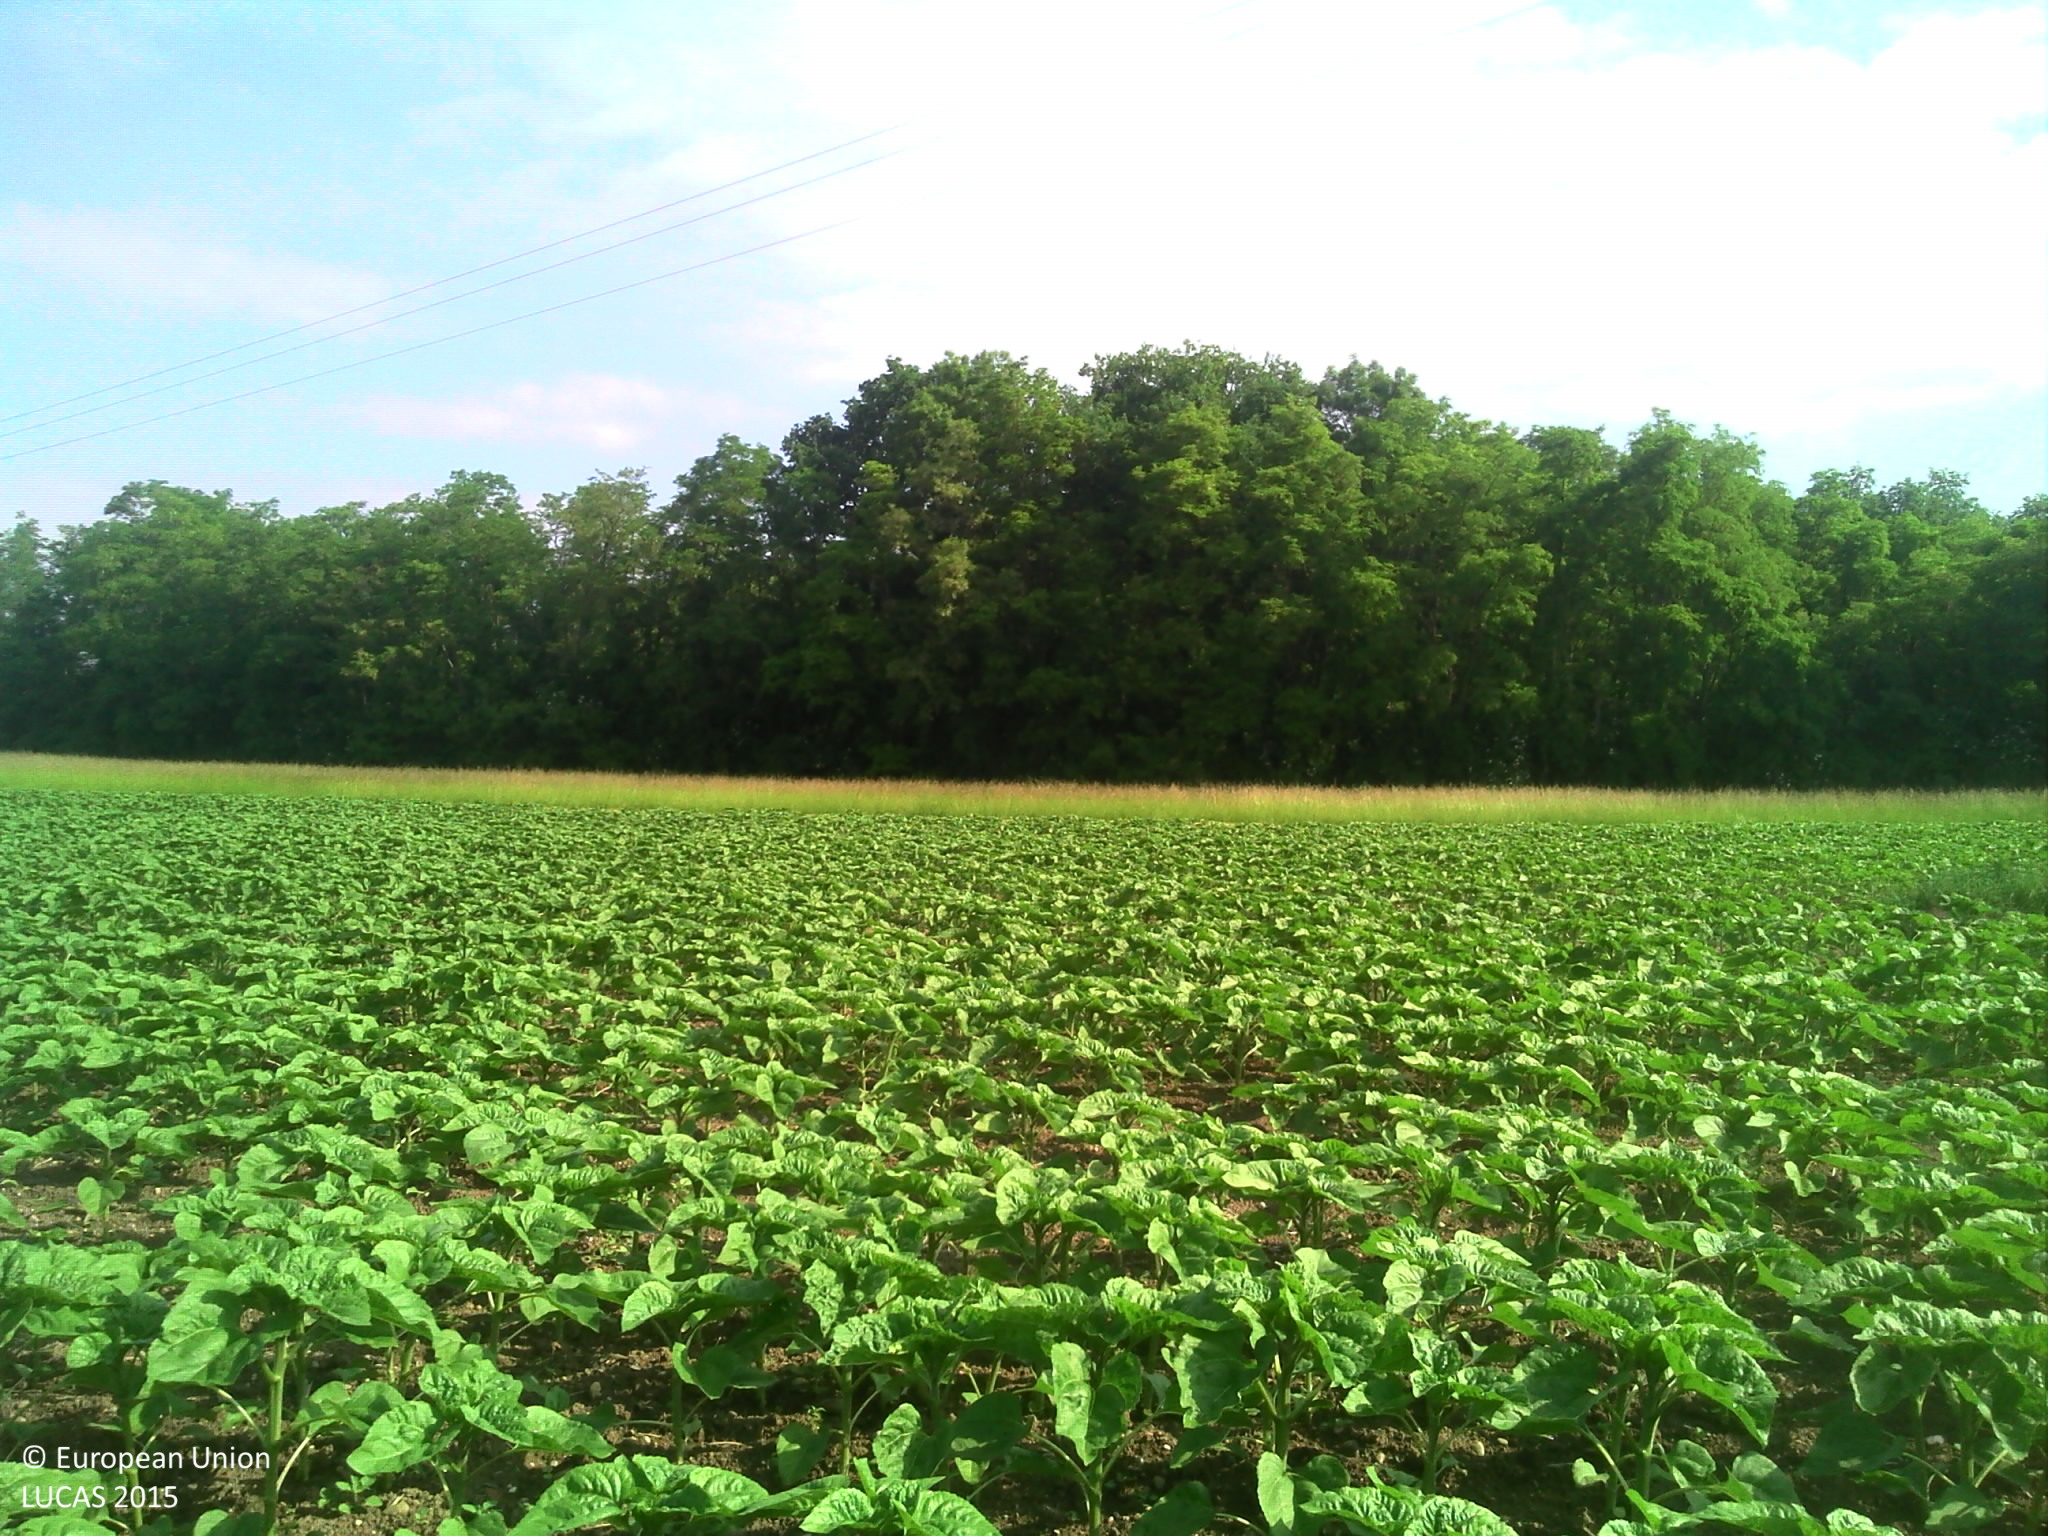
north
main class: Cropland
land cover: Sunflower
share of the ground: 50 - 75 %
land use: Agriculture (excluding fallow land and kitchen gardens)
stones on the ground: < 10 %
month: May
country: FR
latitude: 48.1421
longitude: 7.5417
